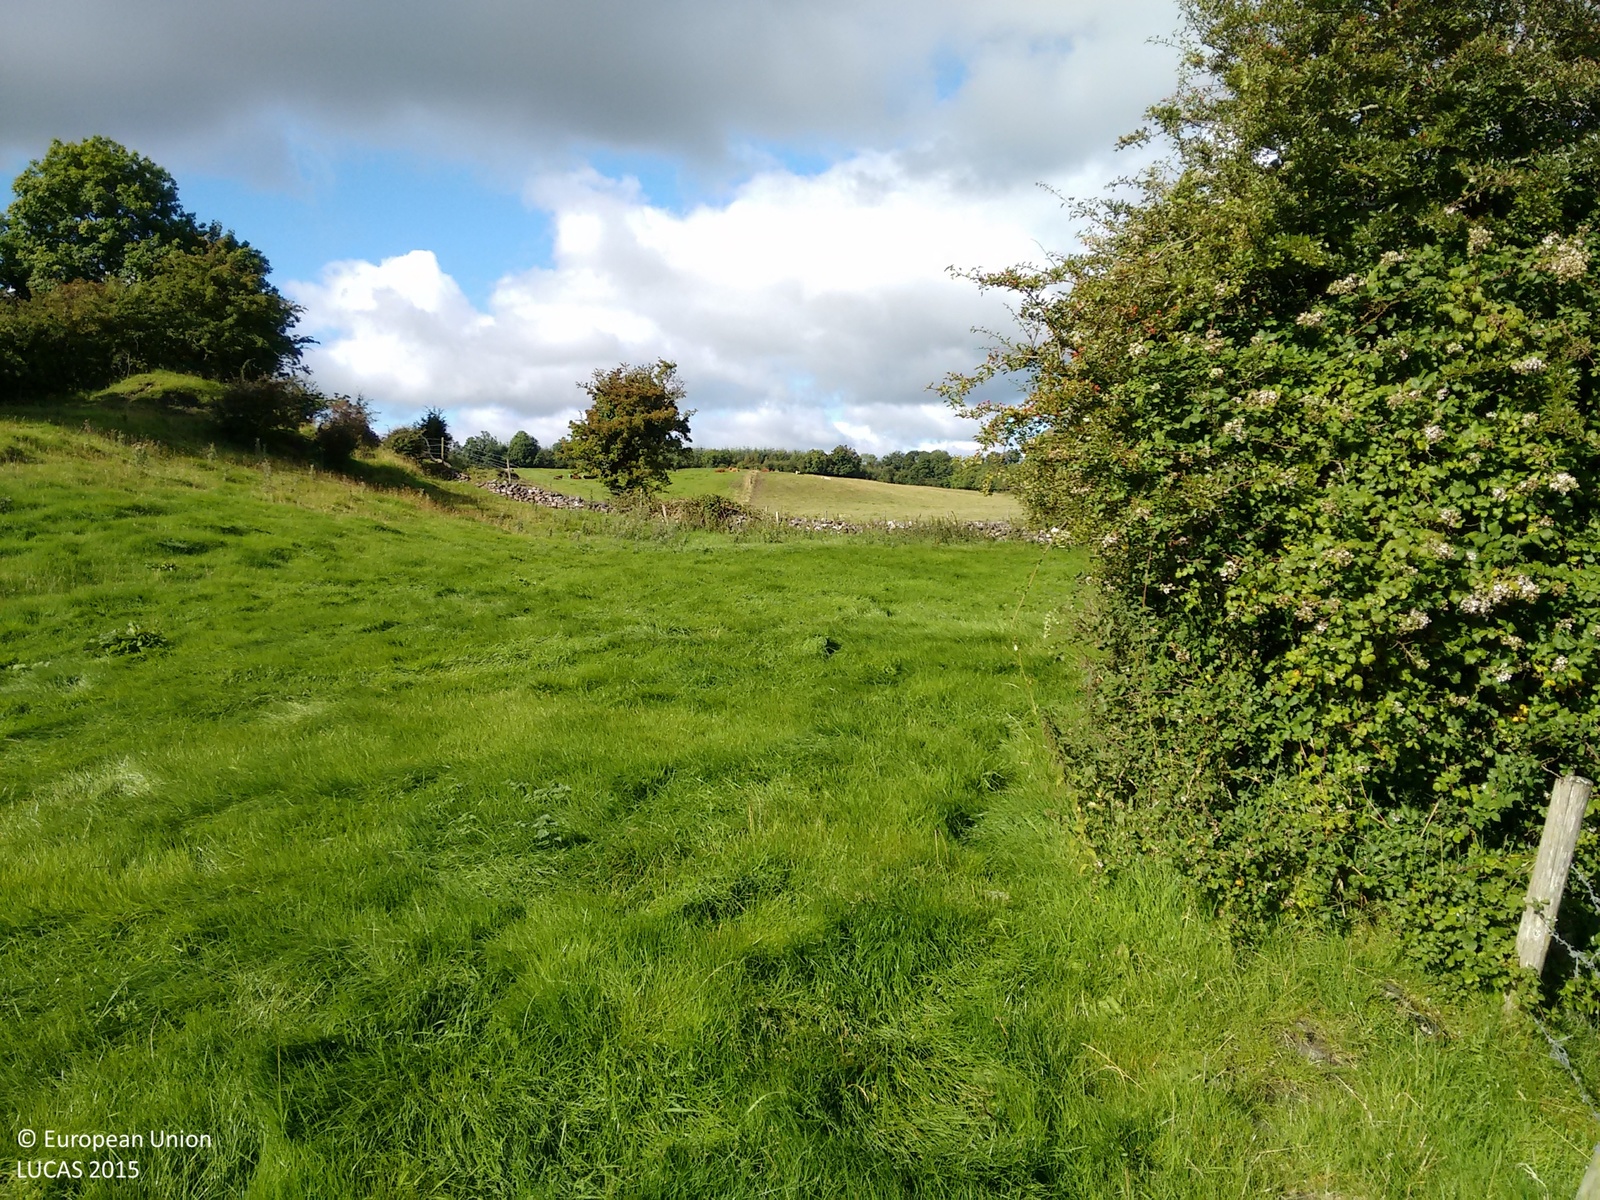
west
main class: Grassland
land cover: Grassland without tree/shrub cover
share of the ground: > 75 %
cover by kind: herbaceous plants 100 %
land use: Agriculture (excluding fallow land and kitchen gardens)
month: September
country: IE
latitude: 53.7010
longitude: -7.0942
